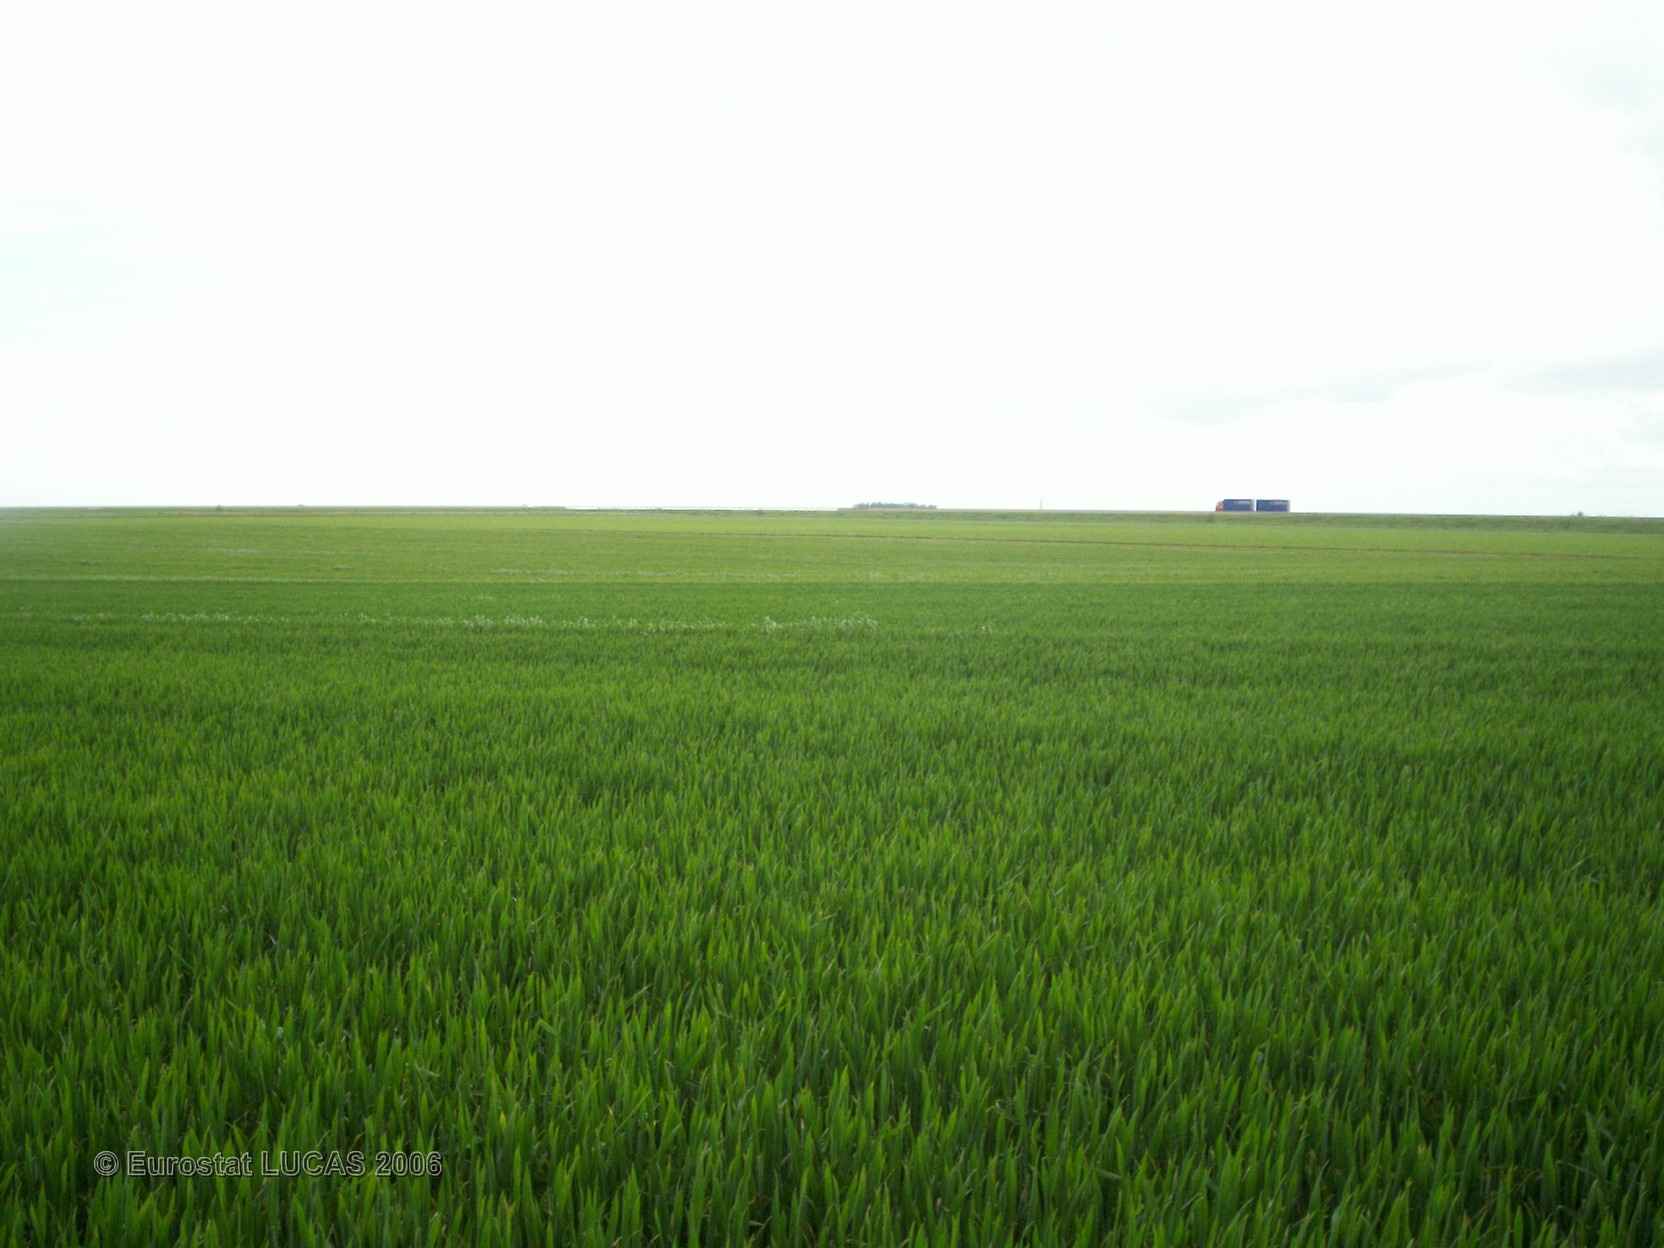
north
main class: Cropland
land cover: Common wheat
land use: Agriculture (excluding fallow land and kitchen gardens)
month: May
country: FR
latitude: 49.8535
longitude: 2.6027
